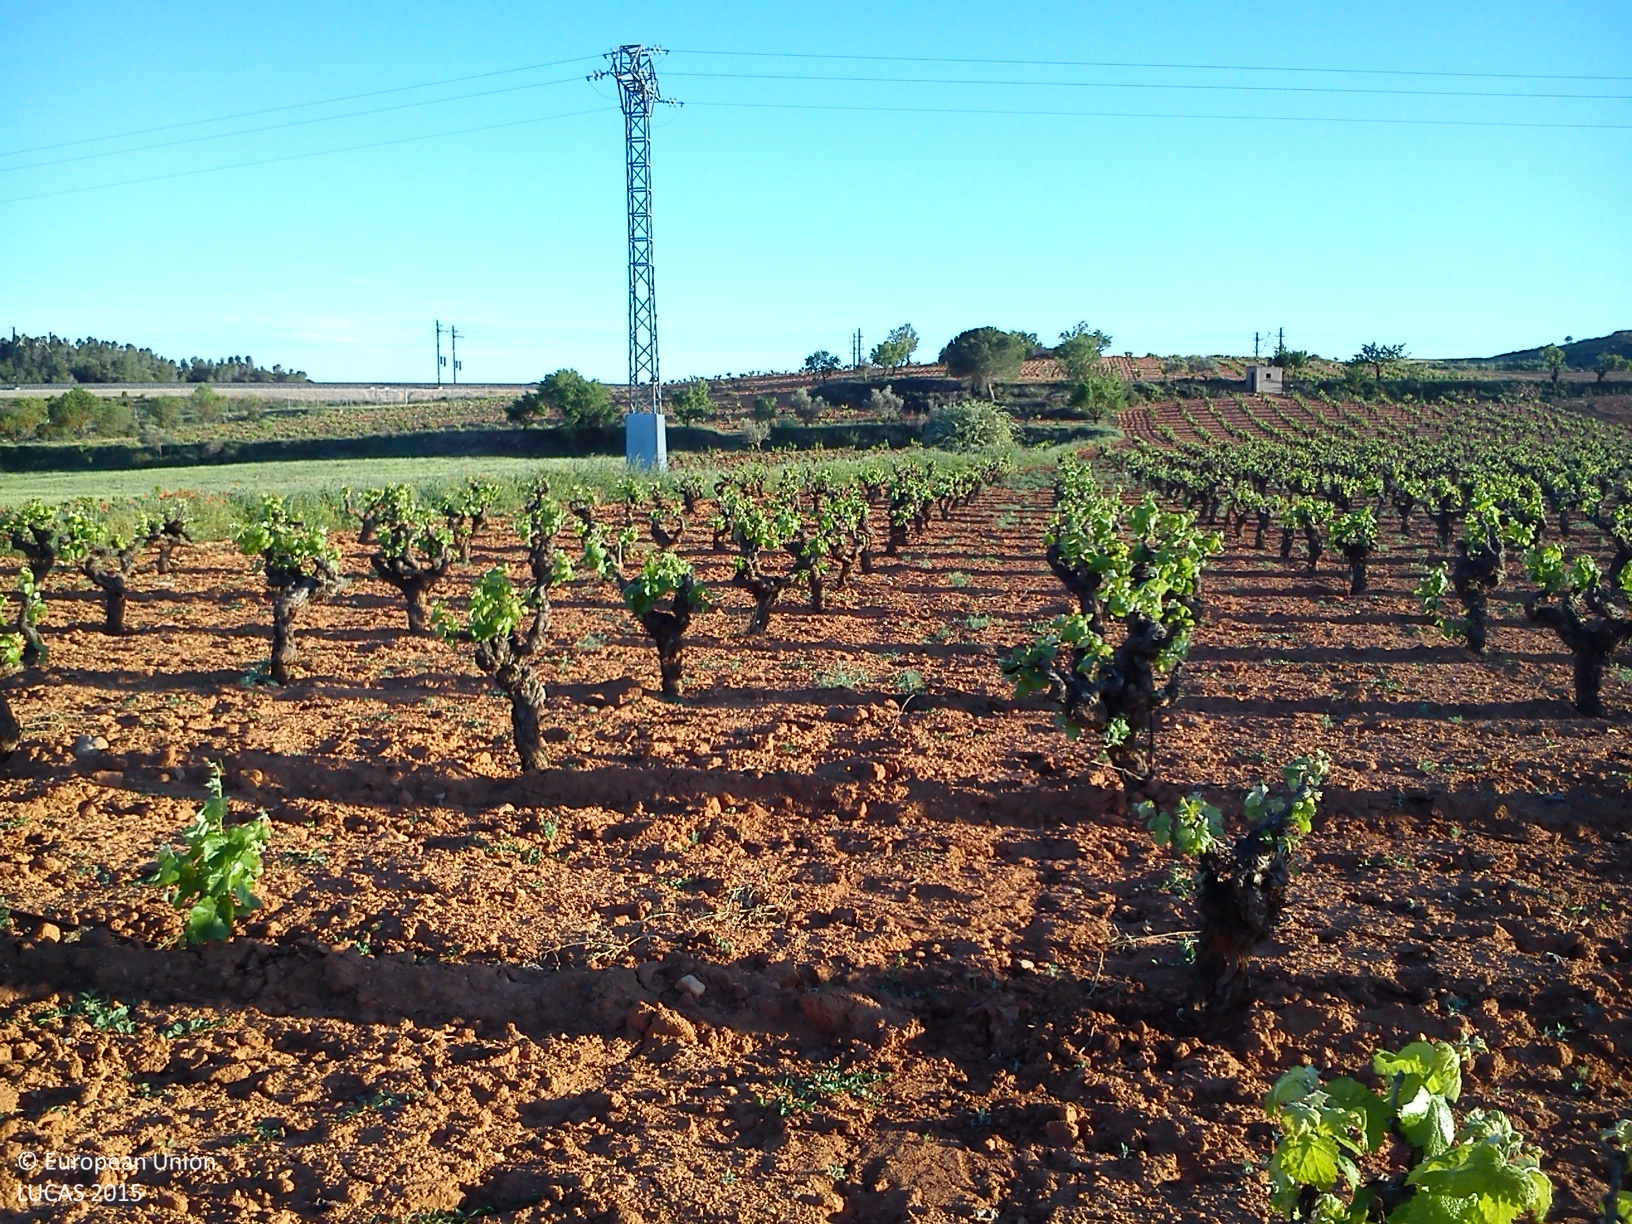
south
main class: Cropland
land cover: Vineyards
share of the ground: 10 - 25 %
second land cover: Other bare soil
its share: > 75 %
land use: Agriculture (excluding fallow land and kitchen gardens)
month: May
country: ES
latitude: 39.5094
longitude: -1.0853
